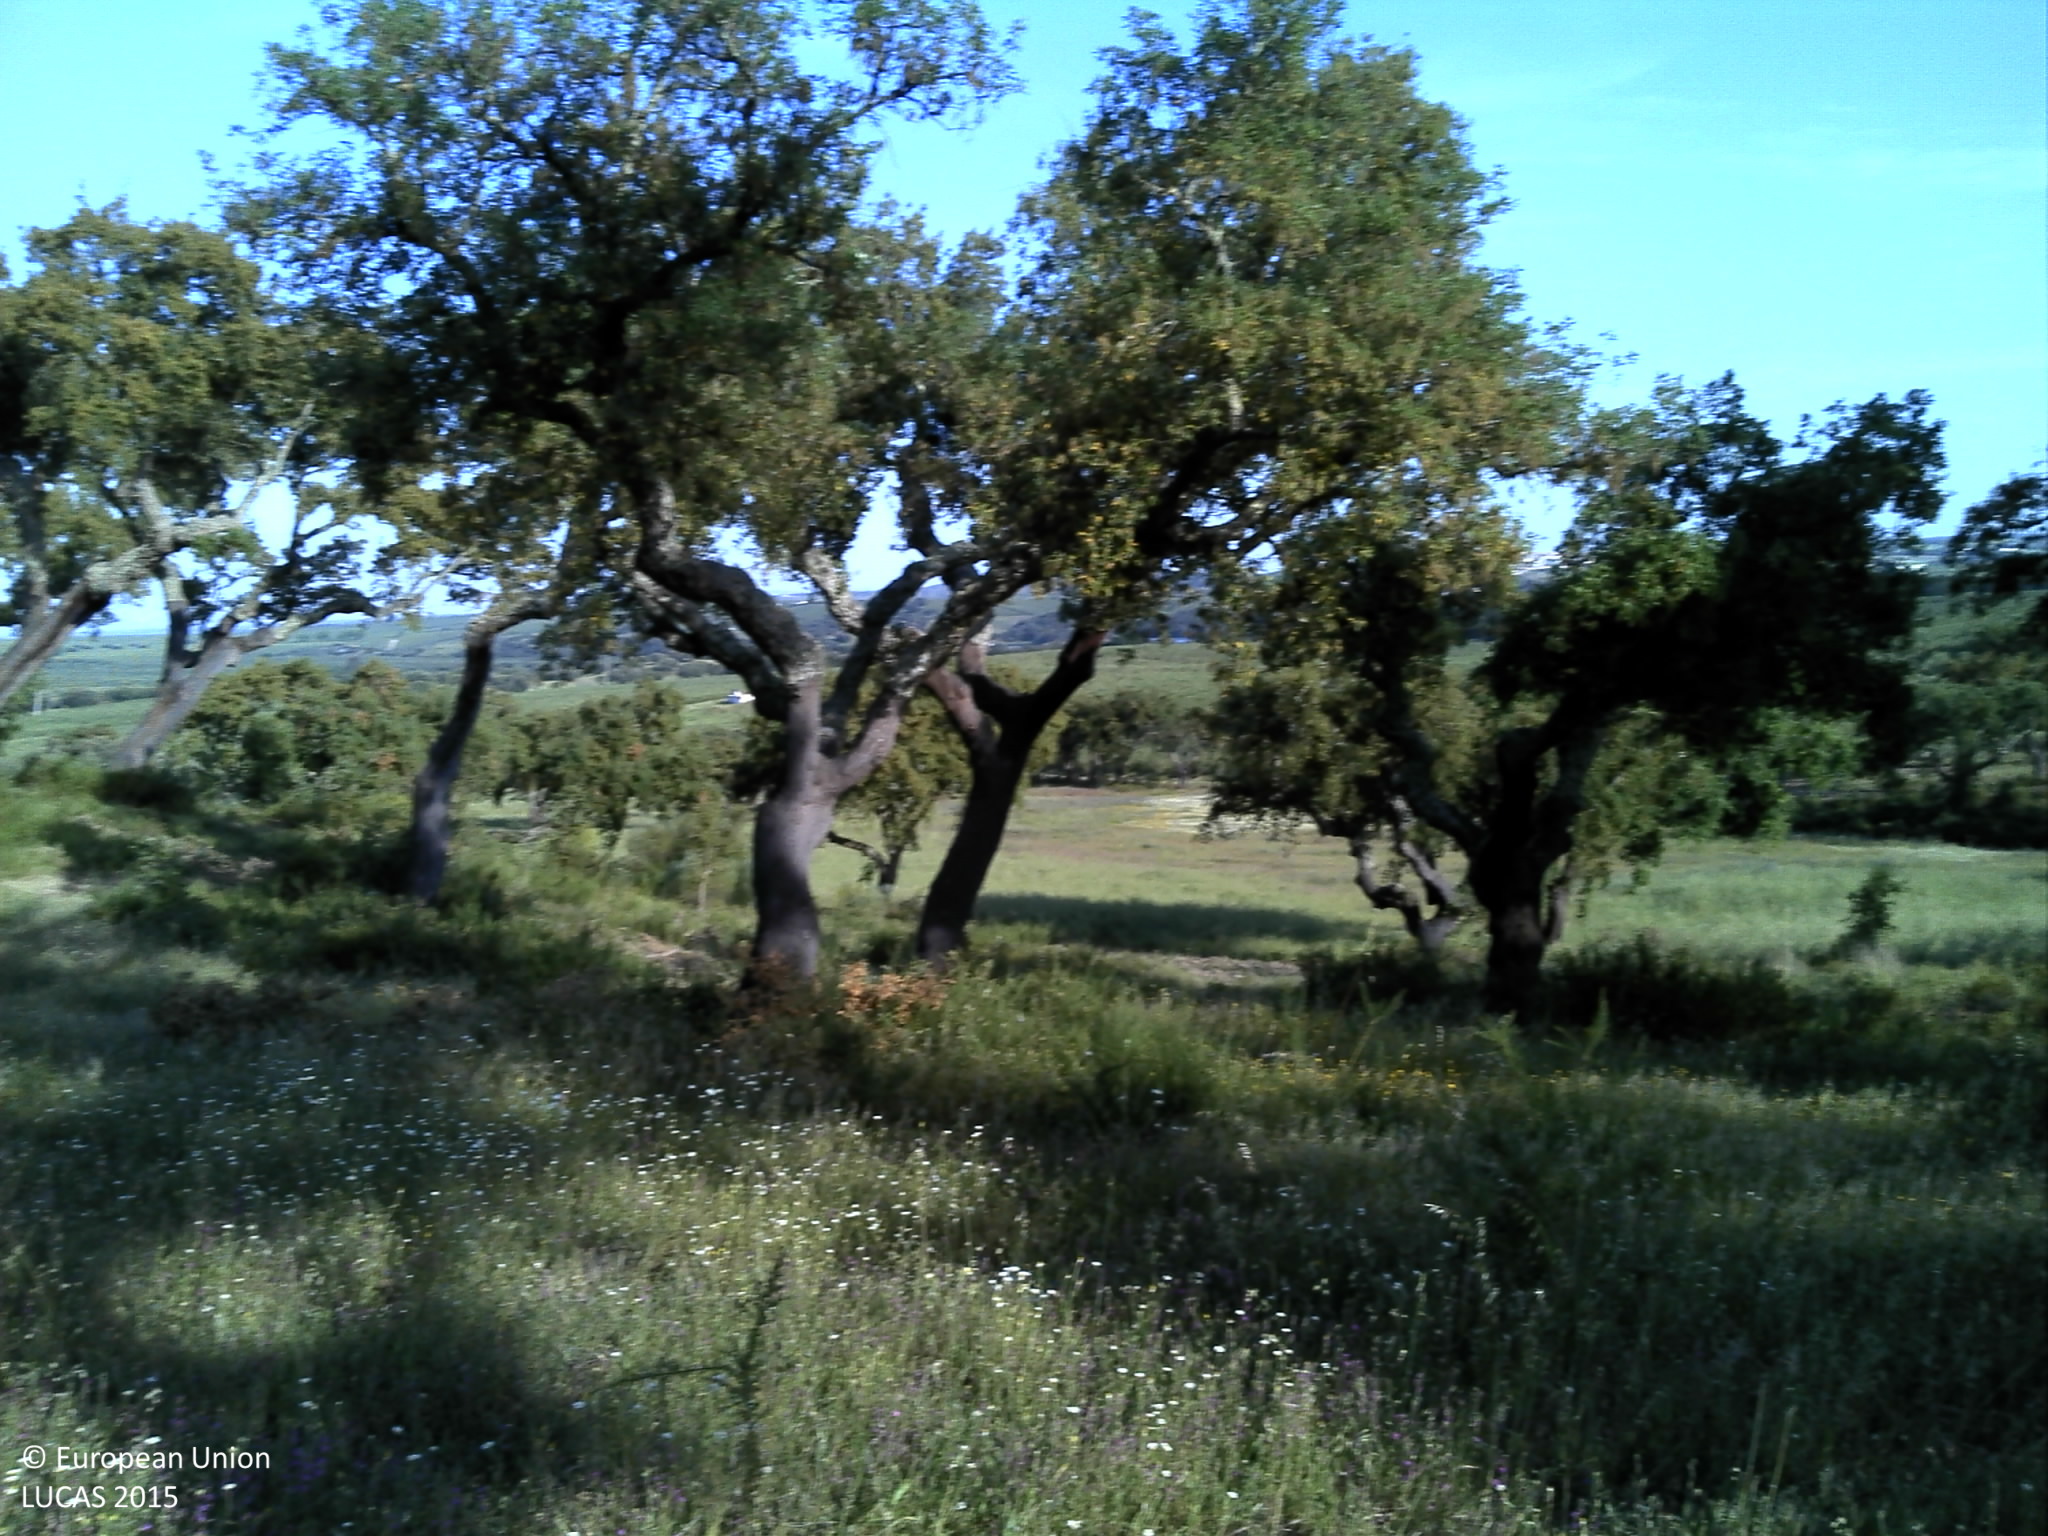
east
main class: Woodland
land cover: Broadleaved woodland
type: broadleaved evergreen forest
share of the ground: 25 - 50 %
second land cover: Grassland without tree/shrub cover
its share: 10 - 25 %
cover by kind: broadleaved forest trees 40 %, herbaceous plants 30 %, consolidated bare surface 30 %
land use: Forestry
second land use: Agriculture (excluding fallow land and kitchen gardens)
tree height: > 5 m
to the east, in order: Broadleaved woodland; Grassland without tree/shrub cover; Broadleaved woodland; Other leguminous and mixtures for fodder
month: May
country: PT
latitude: 39.0845
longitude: -7.9102
